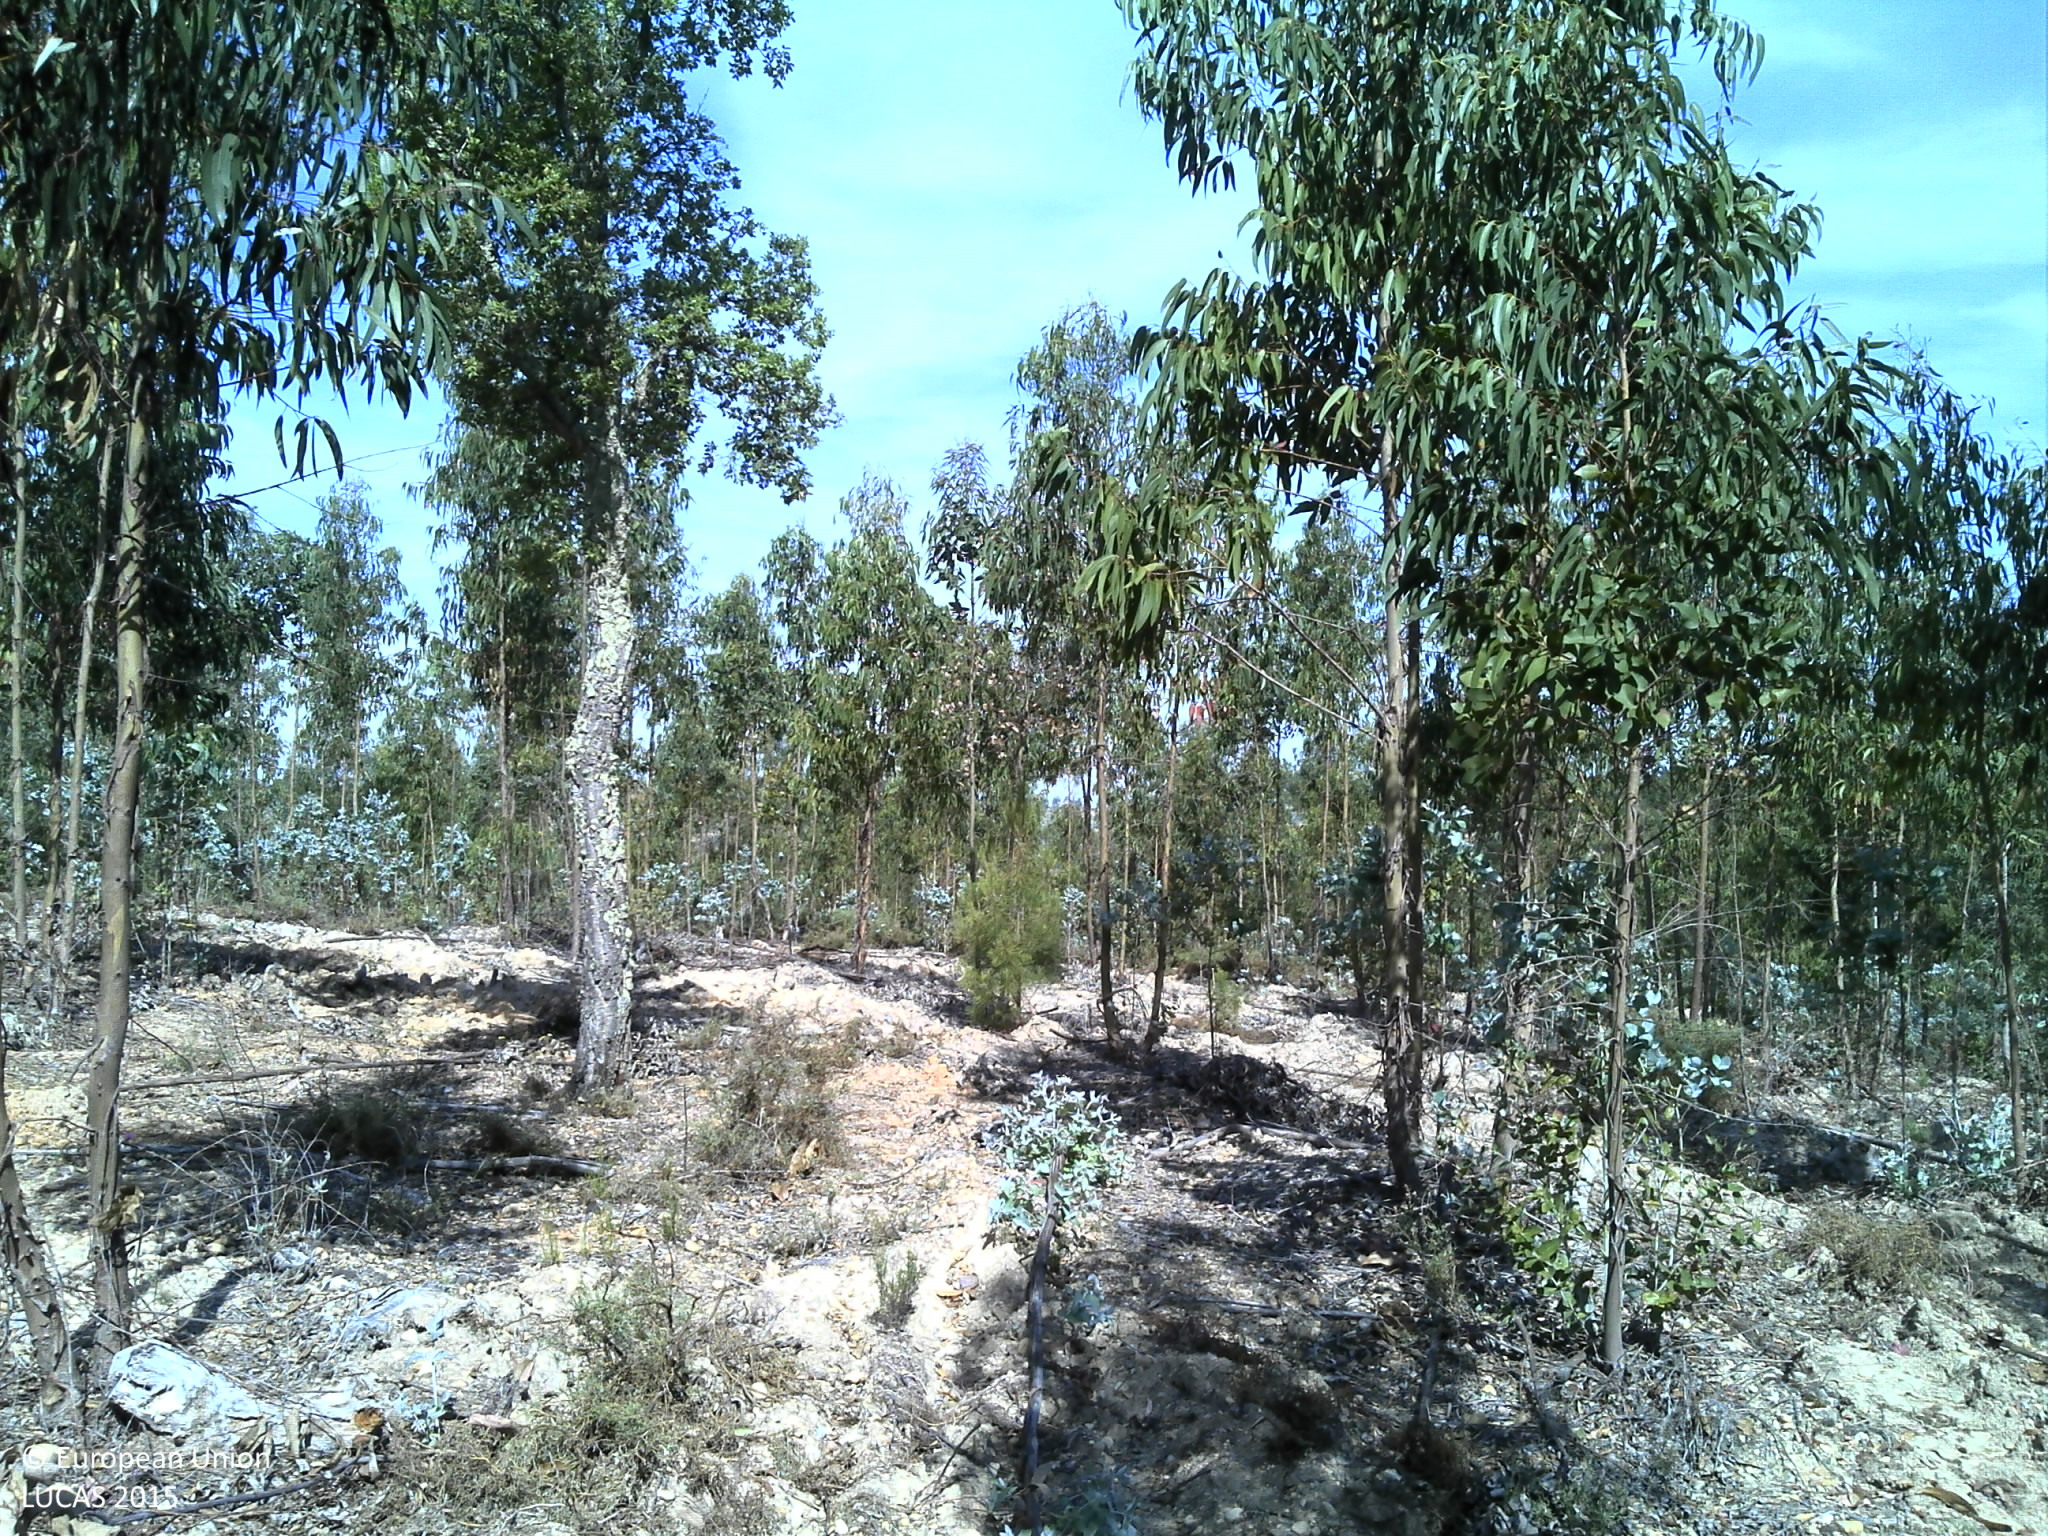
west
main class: Woodland
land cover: Broadleaved woodland
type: exotic forest
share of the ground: 50 - 75 %
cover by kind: broadleaved forest trees 50 %, unconsolidated bare surface 50 %
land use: Forestry
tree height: > 5 m
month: May
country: PT
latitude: 39.2776
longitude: -7.9640
